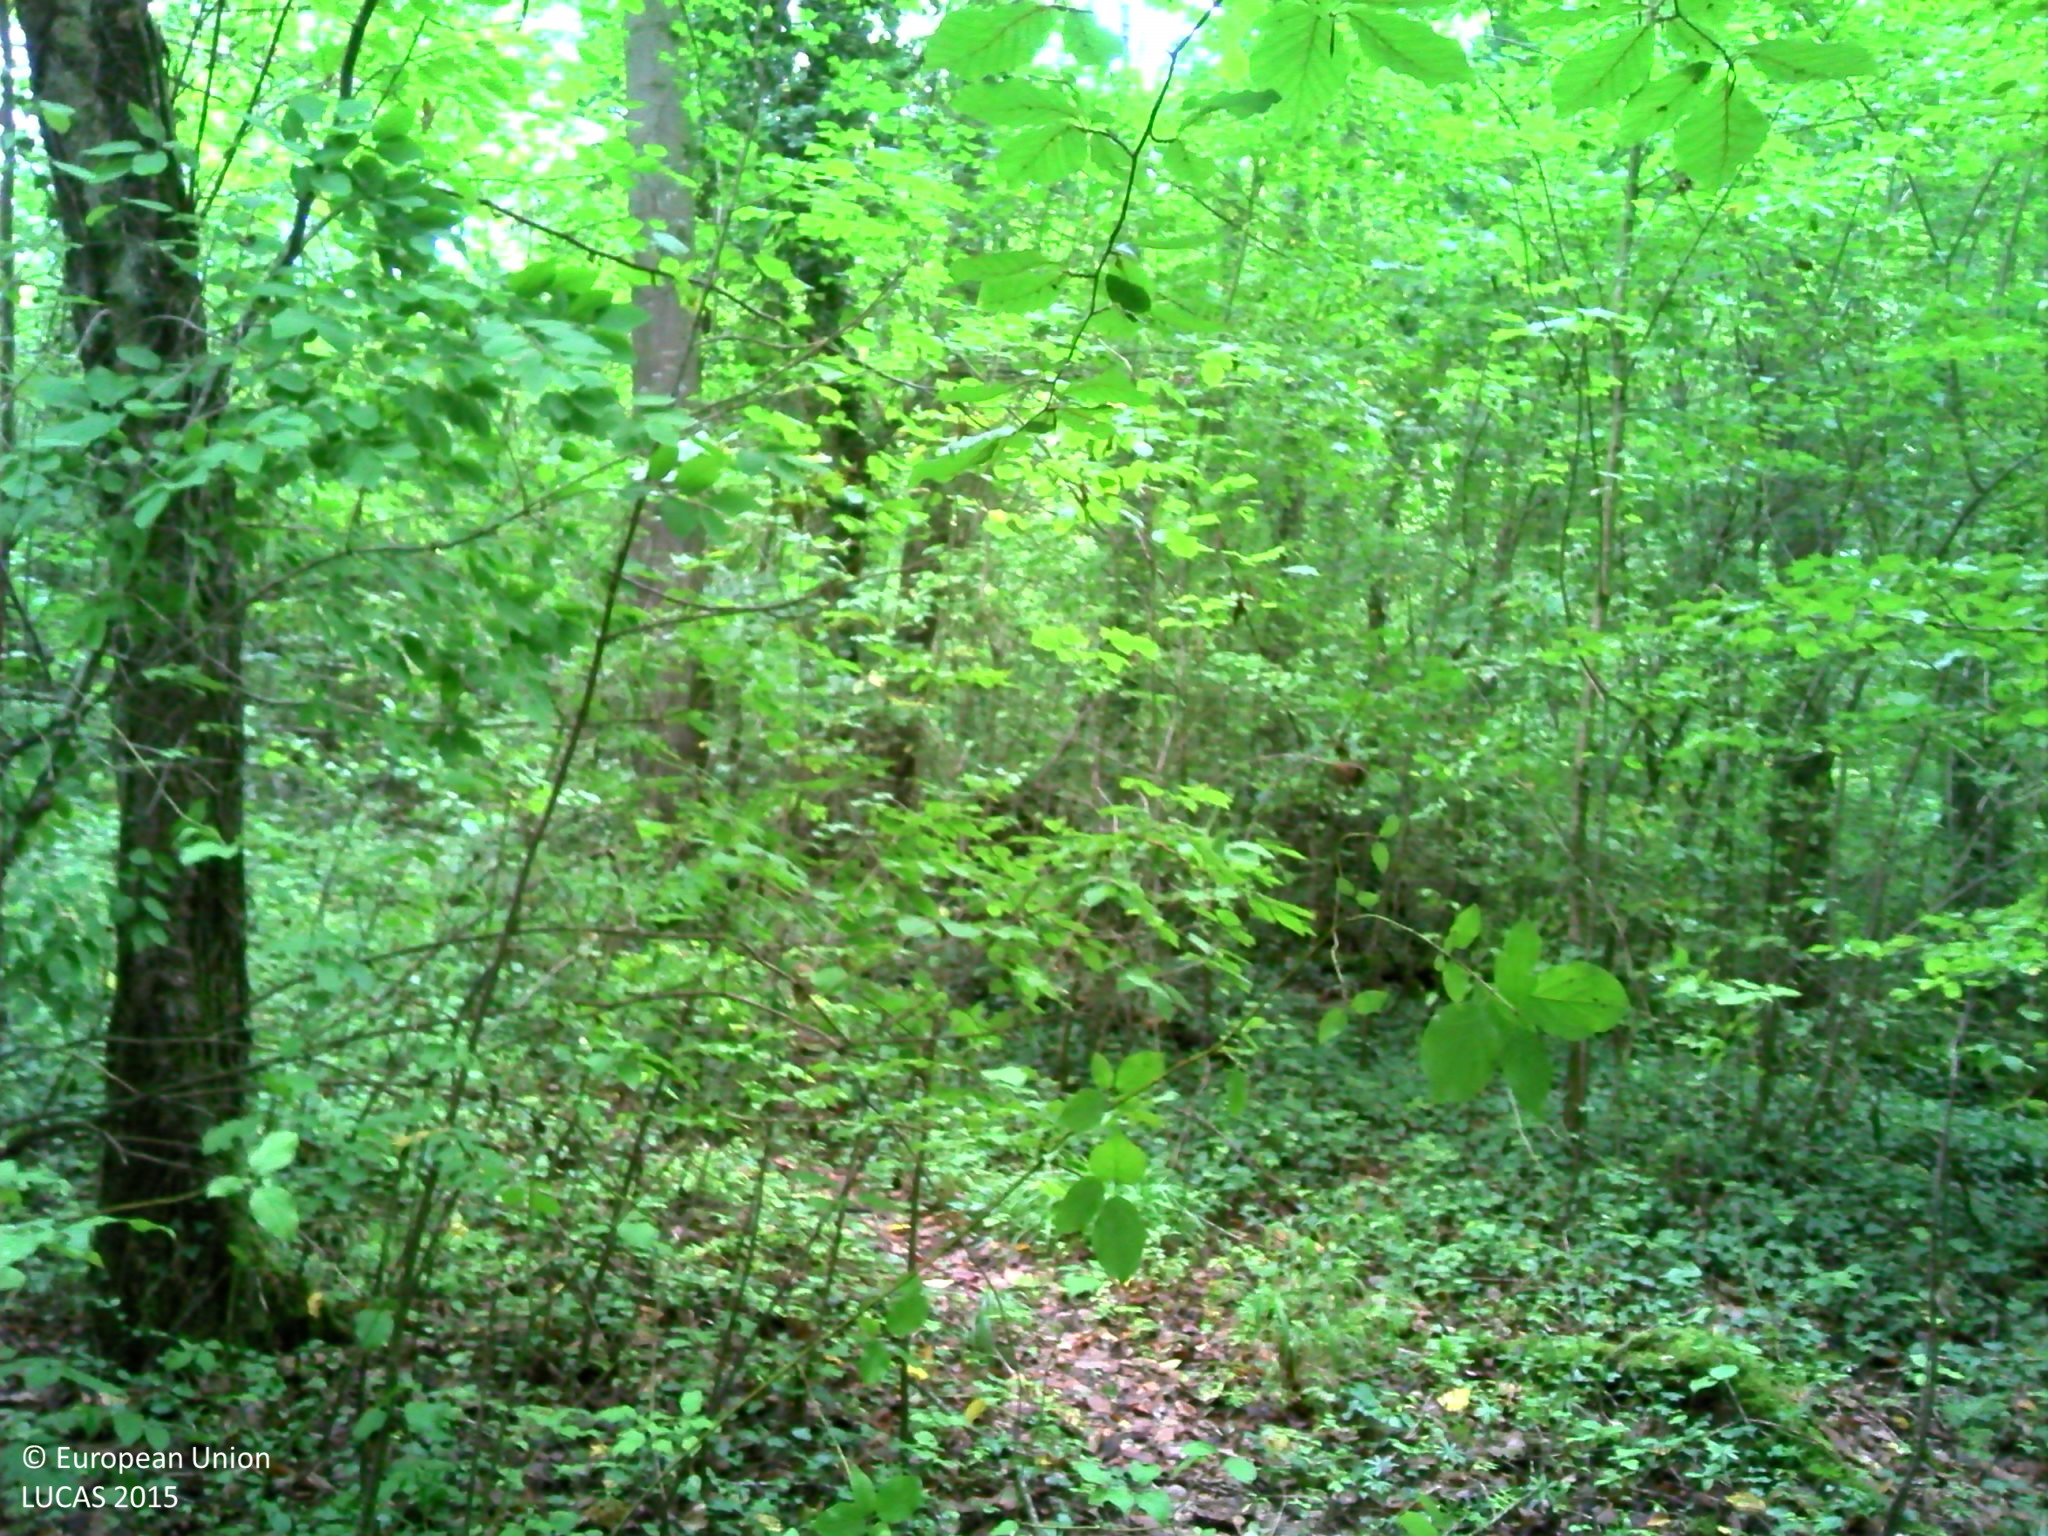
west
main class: Woodland
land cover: Broadleaved woodland
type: mesophytic deciduous forest
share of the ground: > 75 %
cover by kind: broadleaved forest trees 90 %, herbaceous plants 5 %, consolidated bare surface 5 %
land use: Forestry
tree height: > 5 m
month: September
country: FR
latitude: 48.8727
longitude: 6.0322
